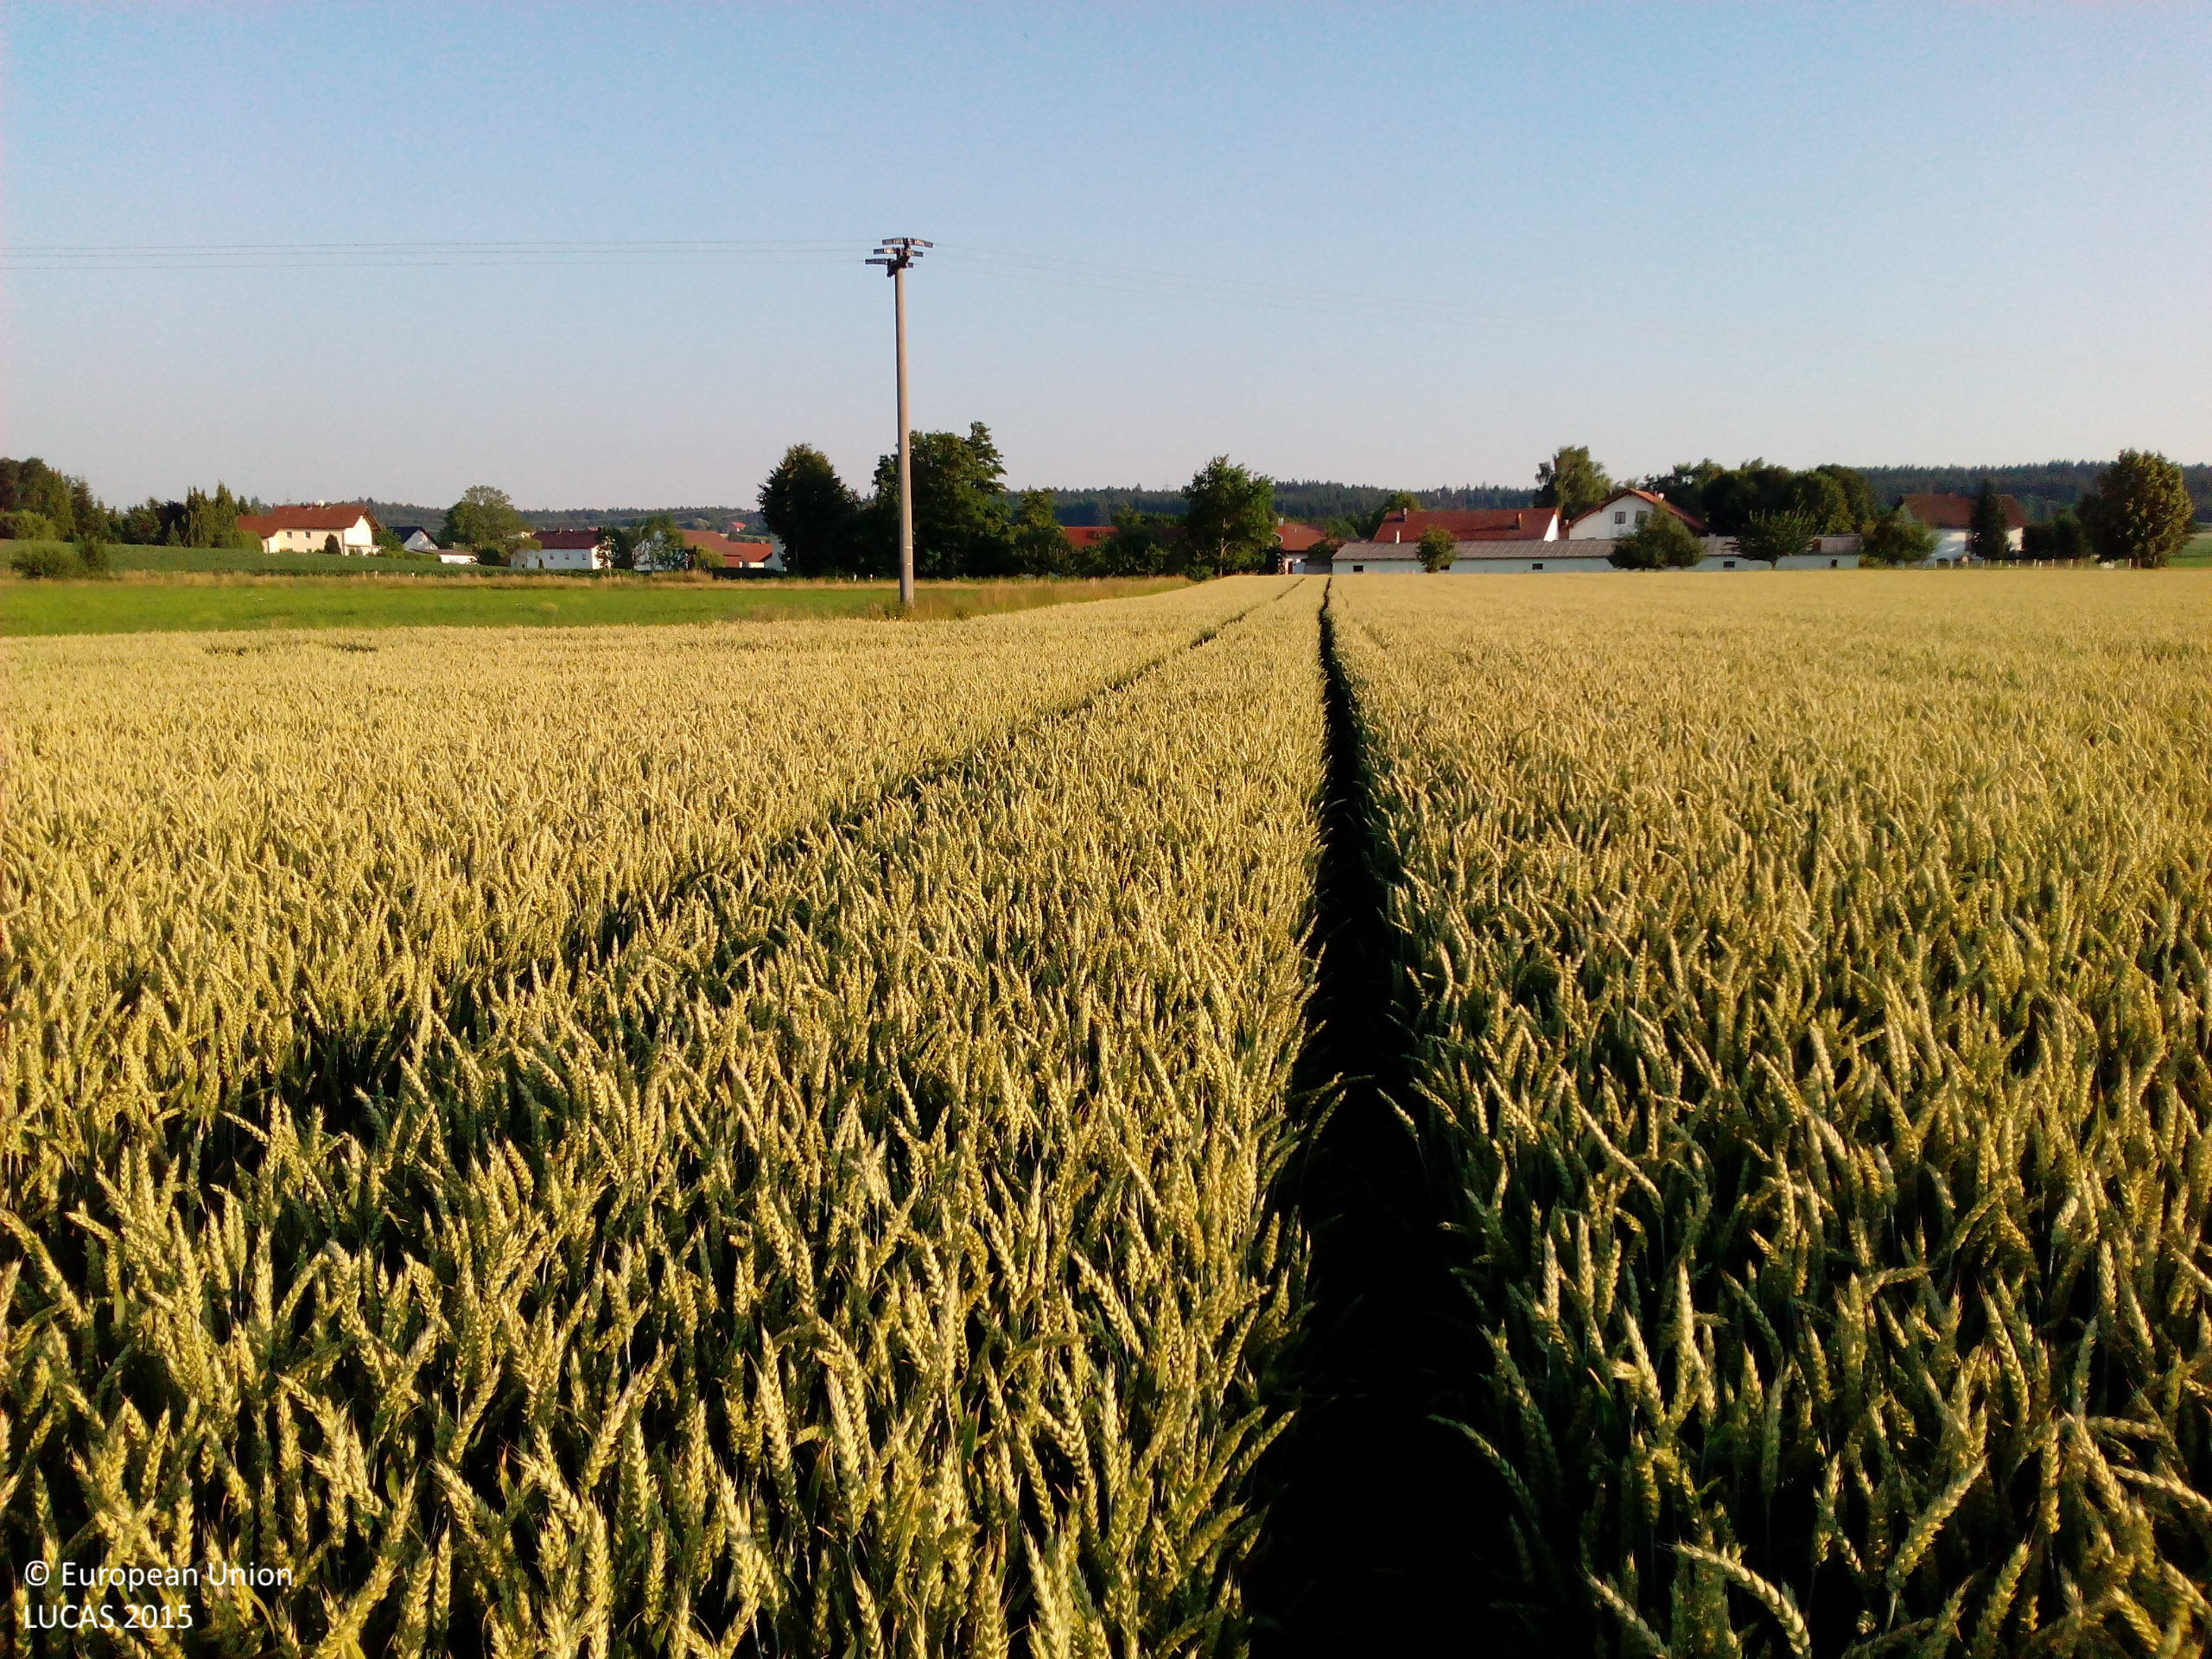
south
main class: Cropland
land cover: Common wheat
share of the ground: > 75 %
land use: Agriculture (excluding fallow land and kitchen gardens)
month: July
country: DE
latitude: 48.6703
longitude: 12.9461
